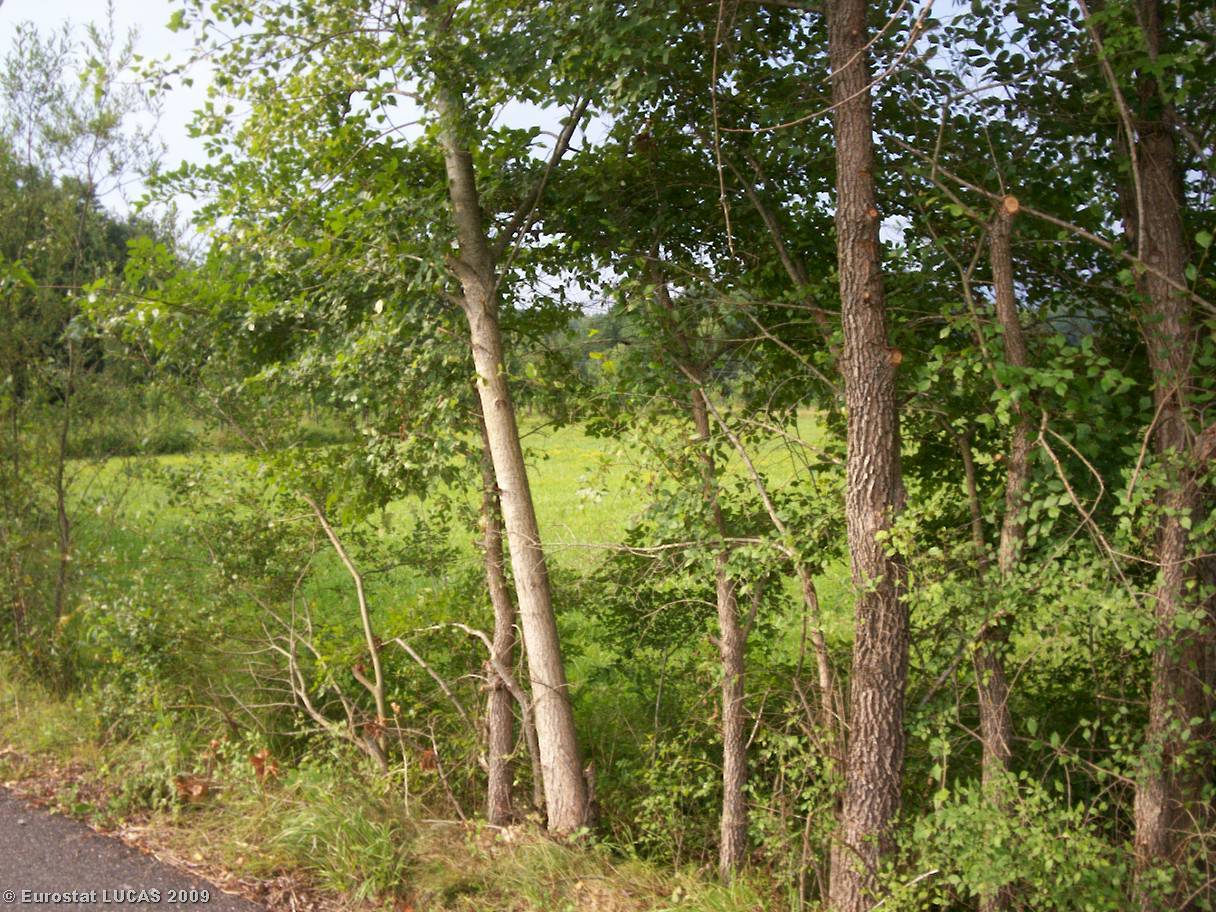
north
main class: Shrubland
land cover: Shrubland with sparse tree cover
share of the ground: > 75 %
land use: Unused
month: July
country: IT
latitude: 44.2604
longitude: 9.9875
